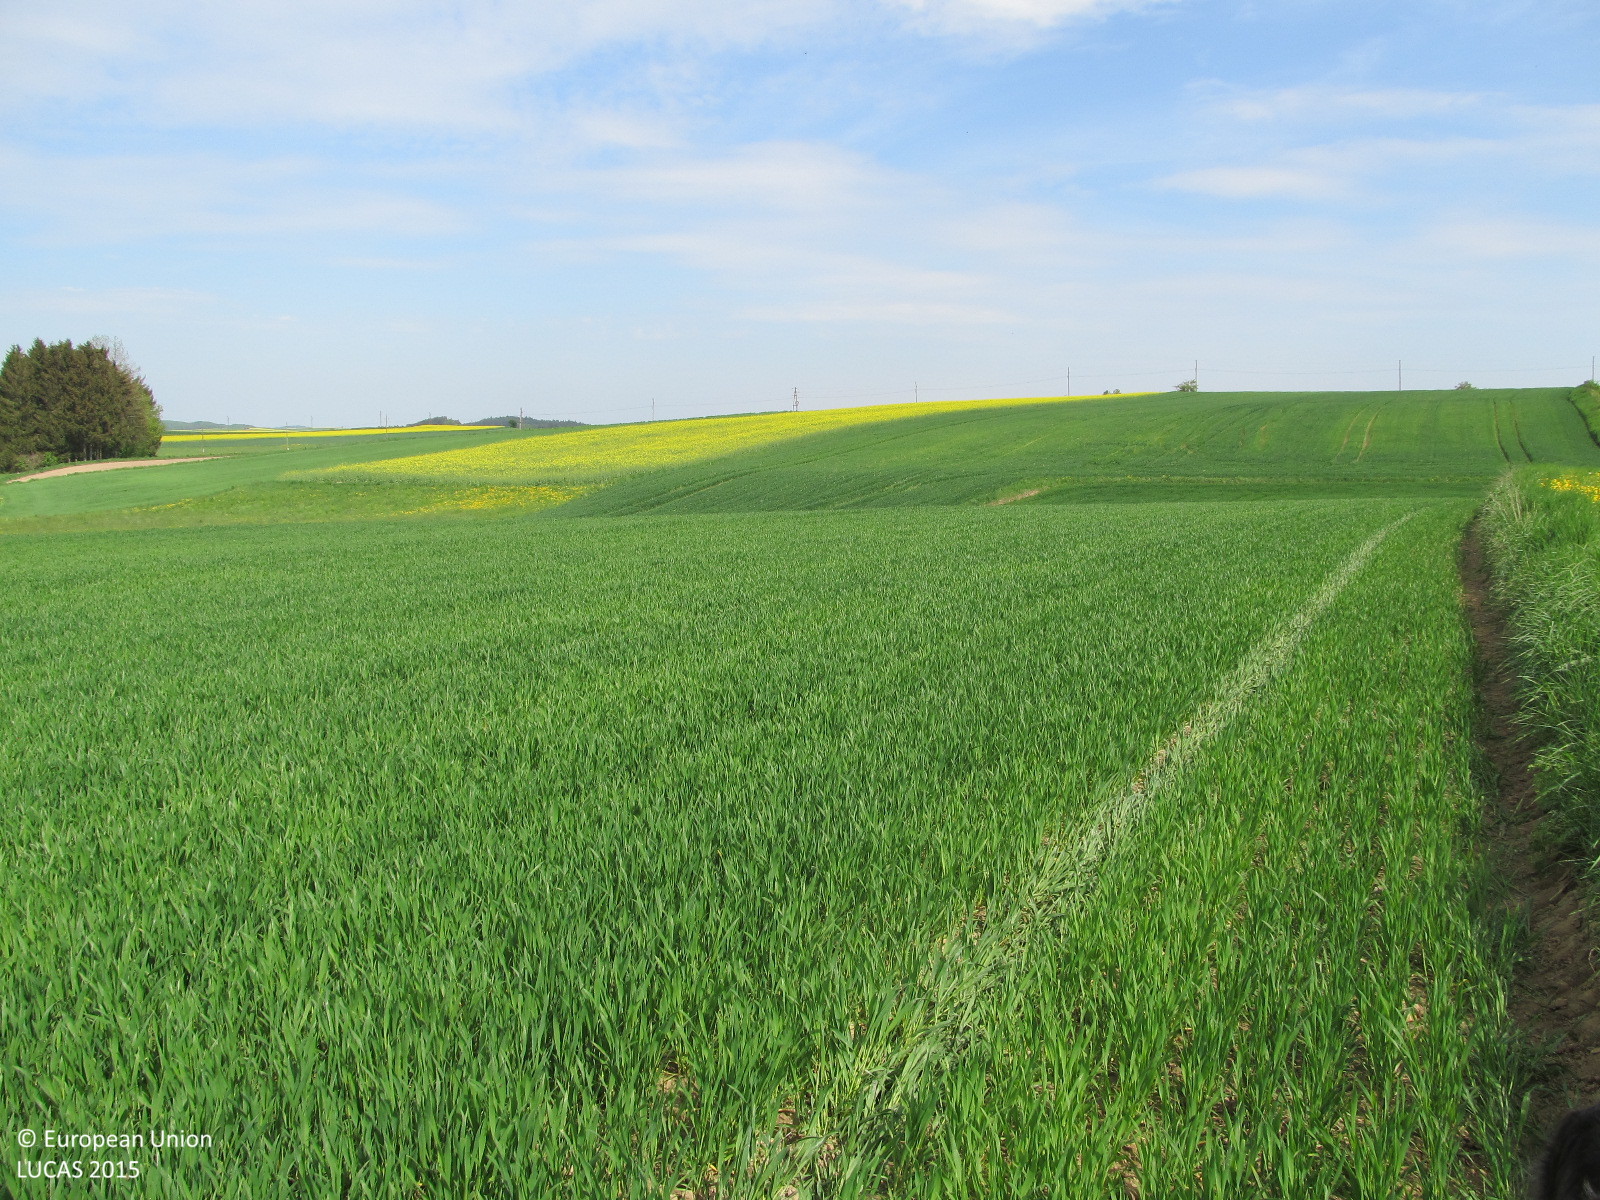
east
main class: Cropland
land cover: Common wheat
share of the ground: 50 - 75 %
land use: Agriculture (excluding fallow land and kitchen gardens)
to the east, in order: Common wheat; Temporary grasslands; Rape and turnip rape; Grass margins; Common wheat; Grass margins; Maize
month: May
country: AT
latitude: 48.5059
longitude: 15.4031
